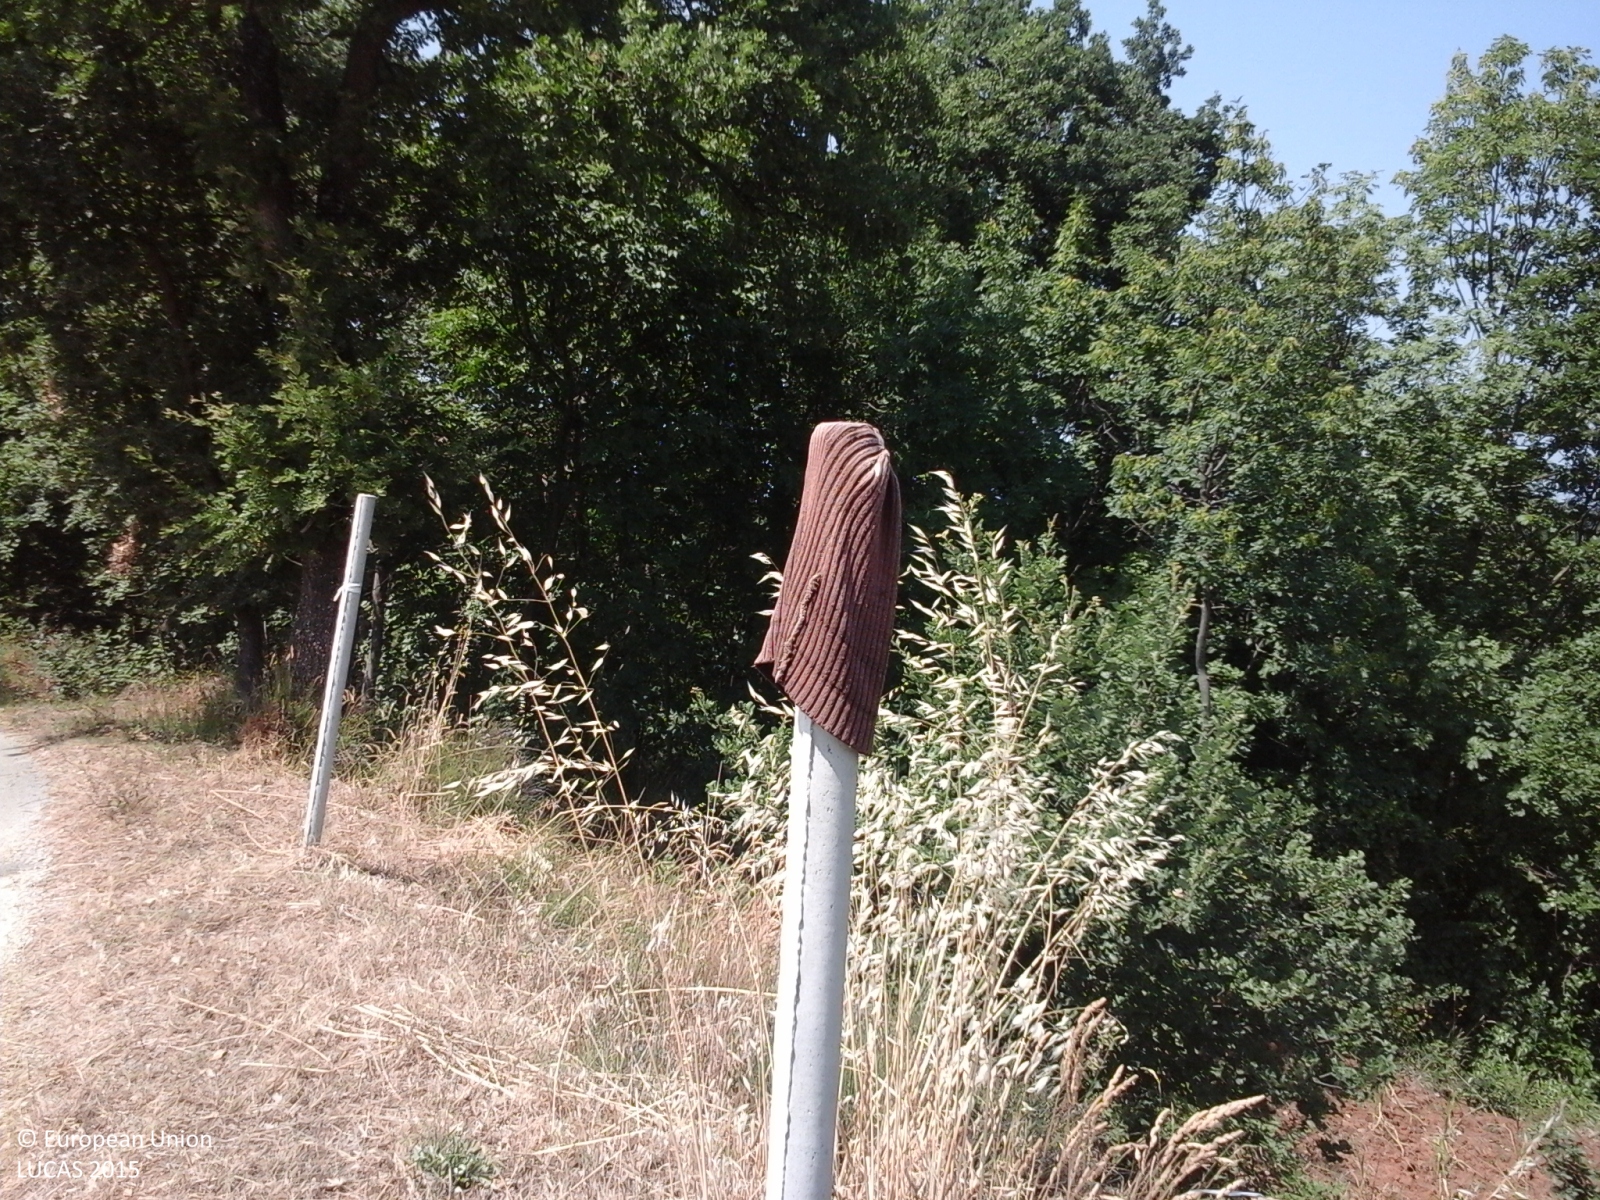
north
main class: Cropland
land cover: Tomatoes
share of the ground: > 75 %
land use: Agriculture (excluding fallow land and kitchen gardens)
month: July
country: IT
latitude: 42.2577
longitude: 14.2417
